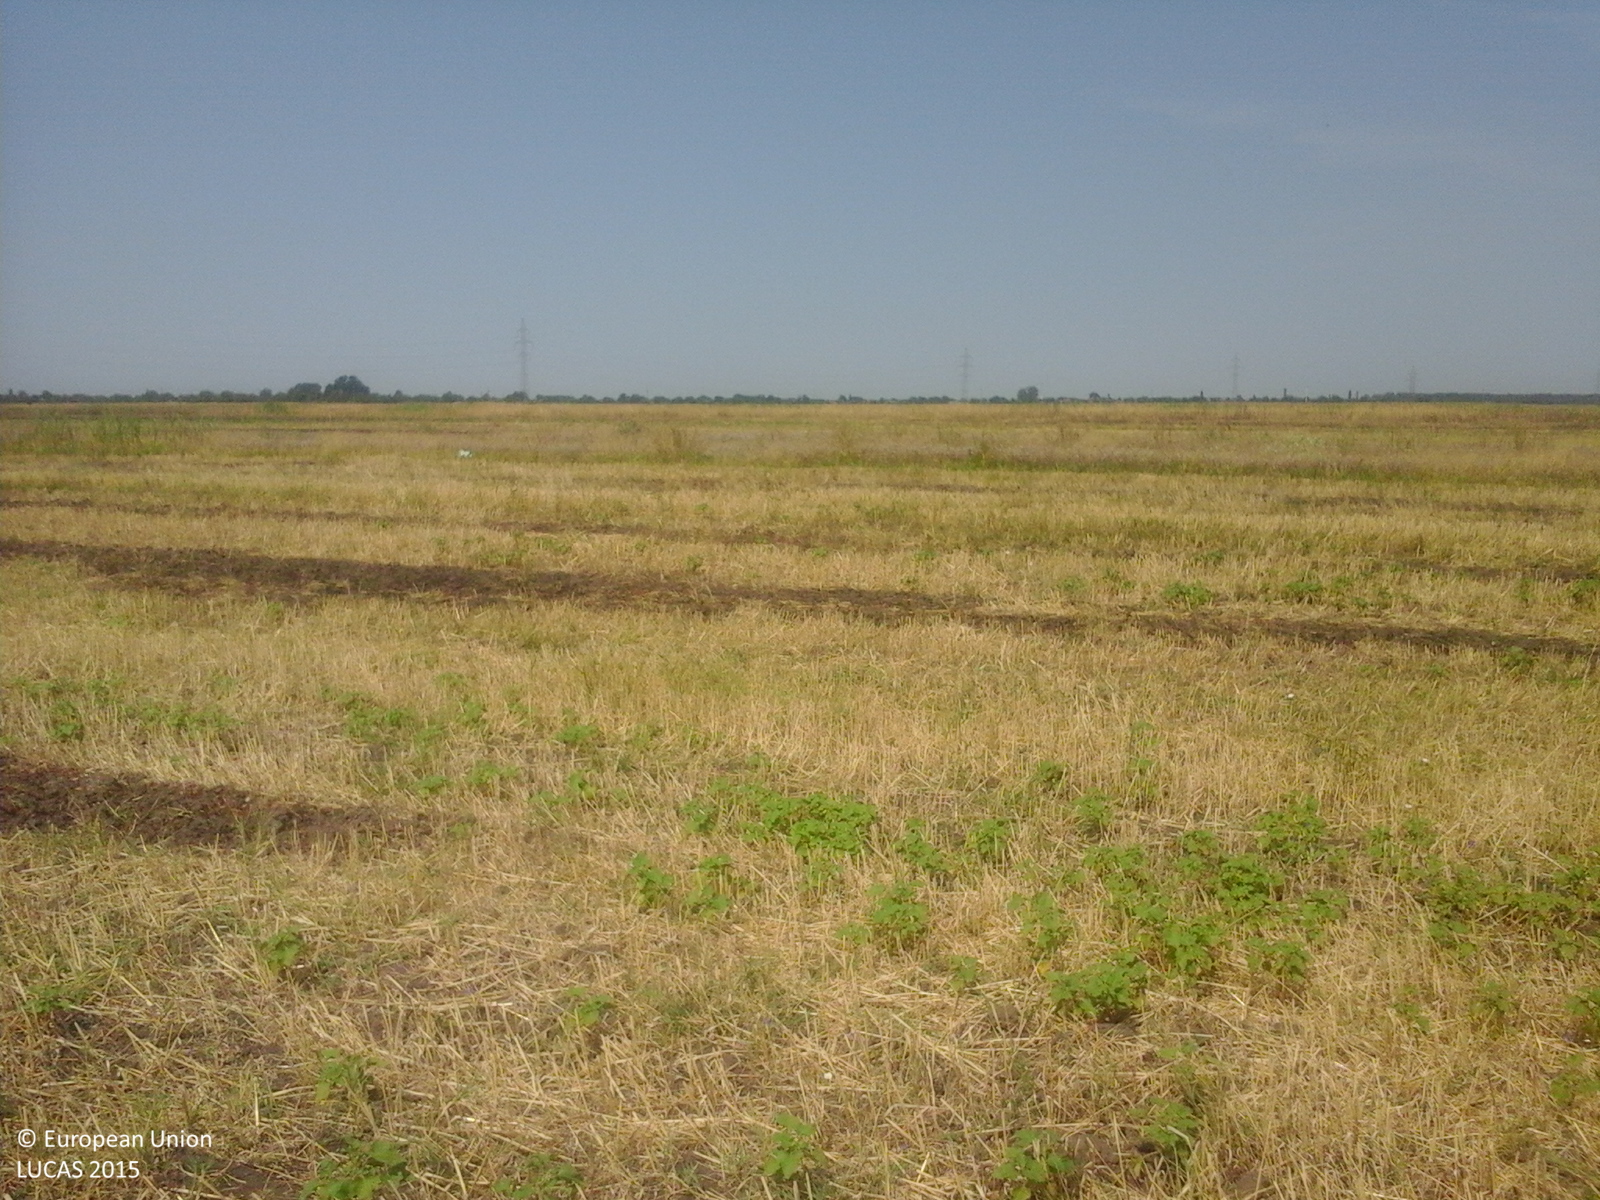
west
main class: Cropland
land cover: Barley
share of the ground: < 10 %
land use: Agriculture (excluding fallow land and kitchen gardens)
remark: Burnt area
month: August
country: RO
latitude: 44.2464
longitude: 22.9538
